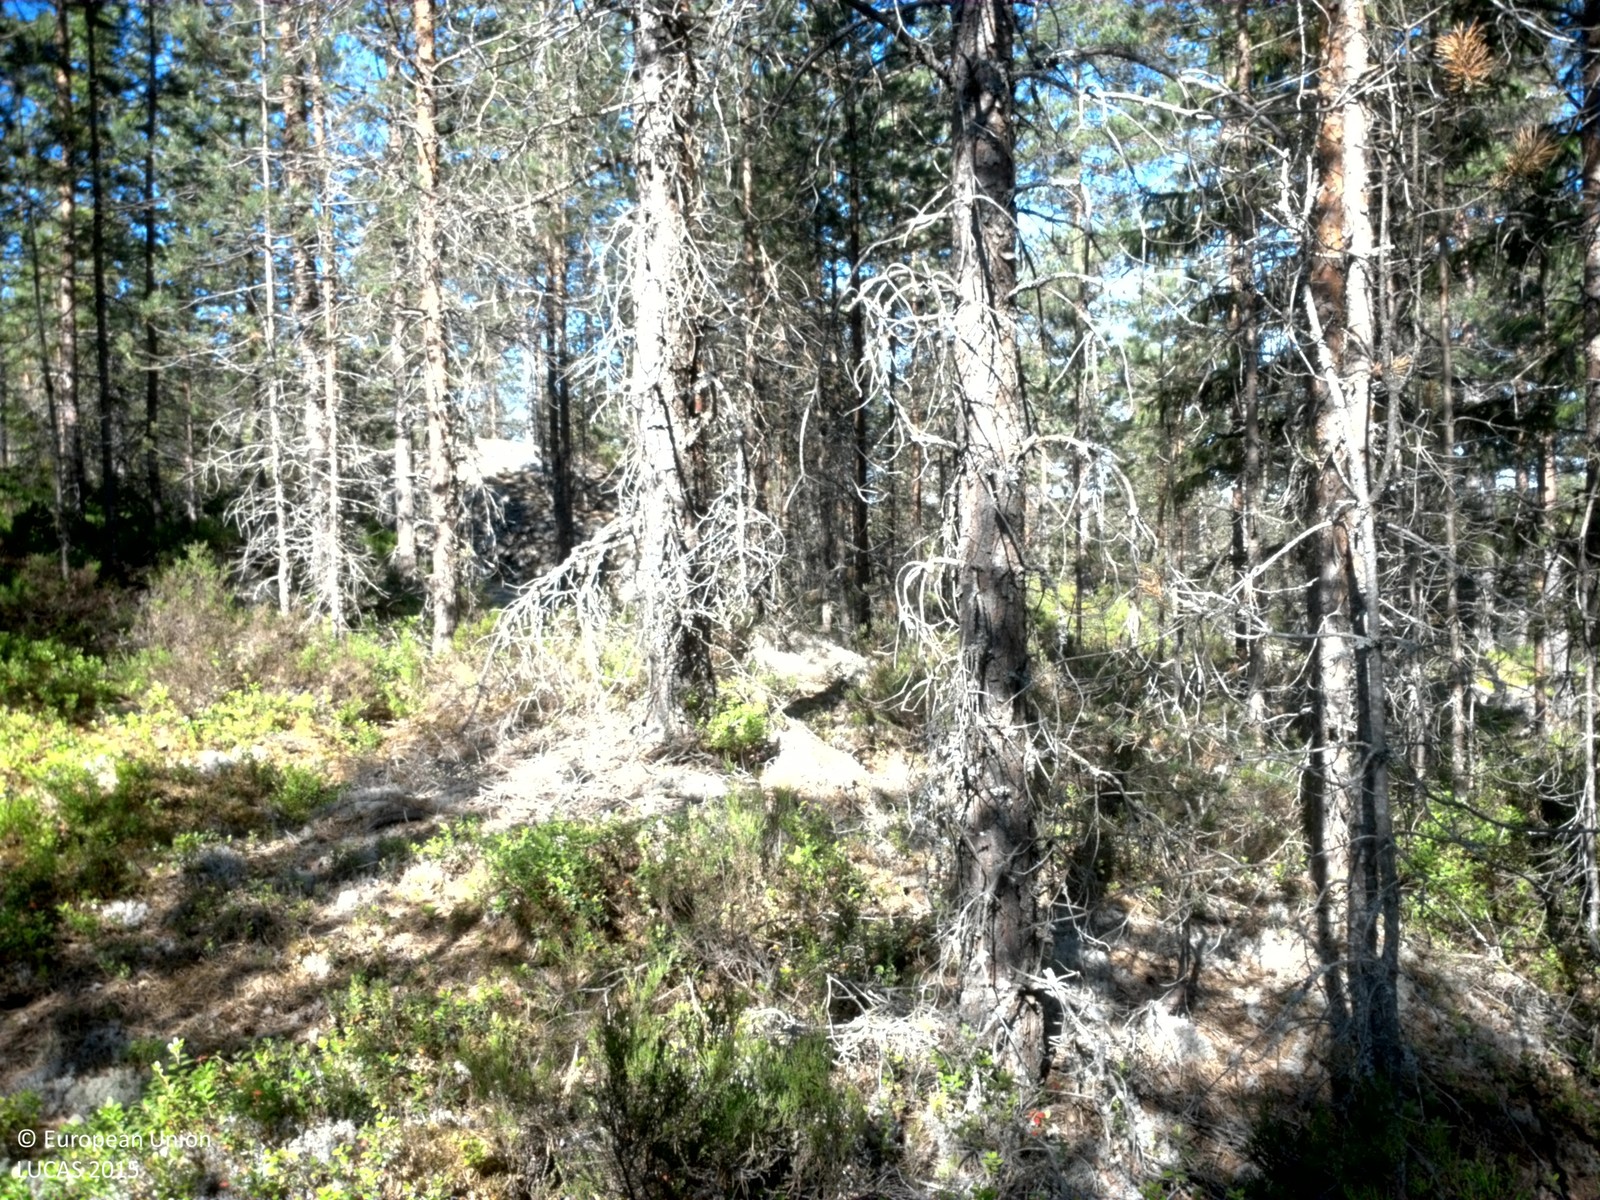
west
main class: Woodland
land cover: Pine dominated coniferous woodland
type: boreal forest
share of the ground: 25 - 50 %
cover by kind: coniferous forest trees 45 %, shrubs 25 %, lichens and mosses 20 %, broadleaved forest trees 5 %, herbaceous plants 5 %
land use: Forestry
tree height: > 5 m
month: July
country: SE
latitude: 59.8072
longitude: 11.9376
